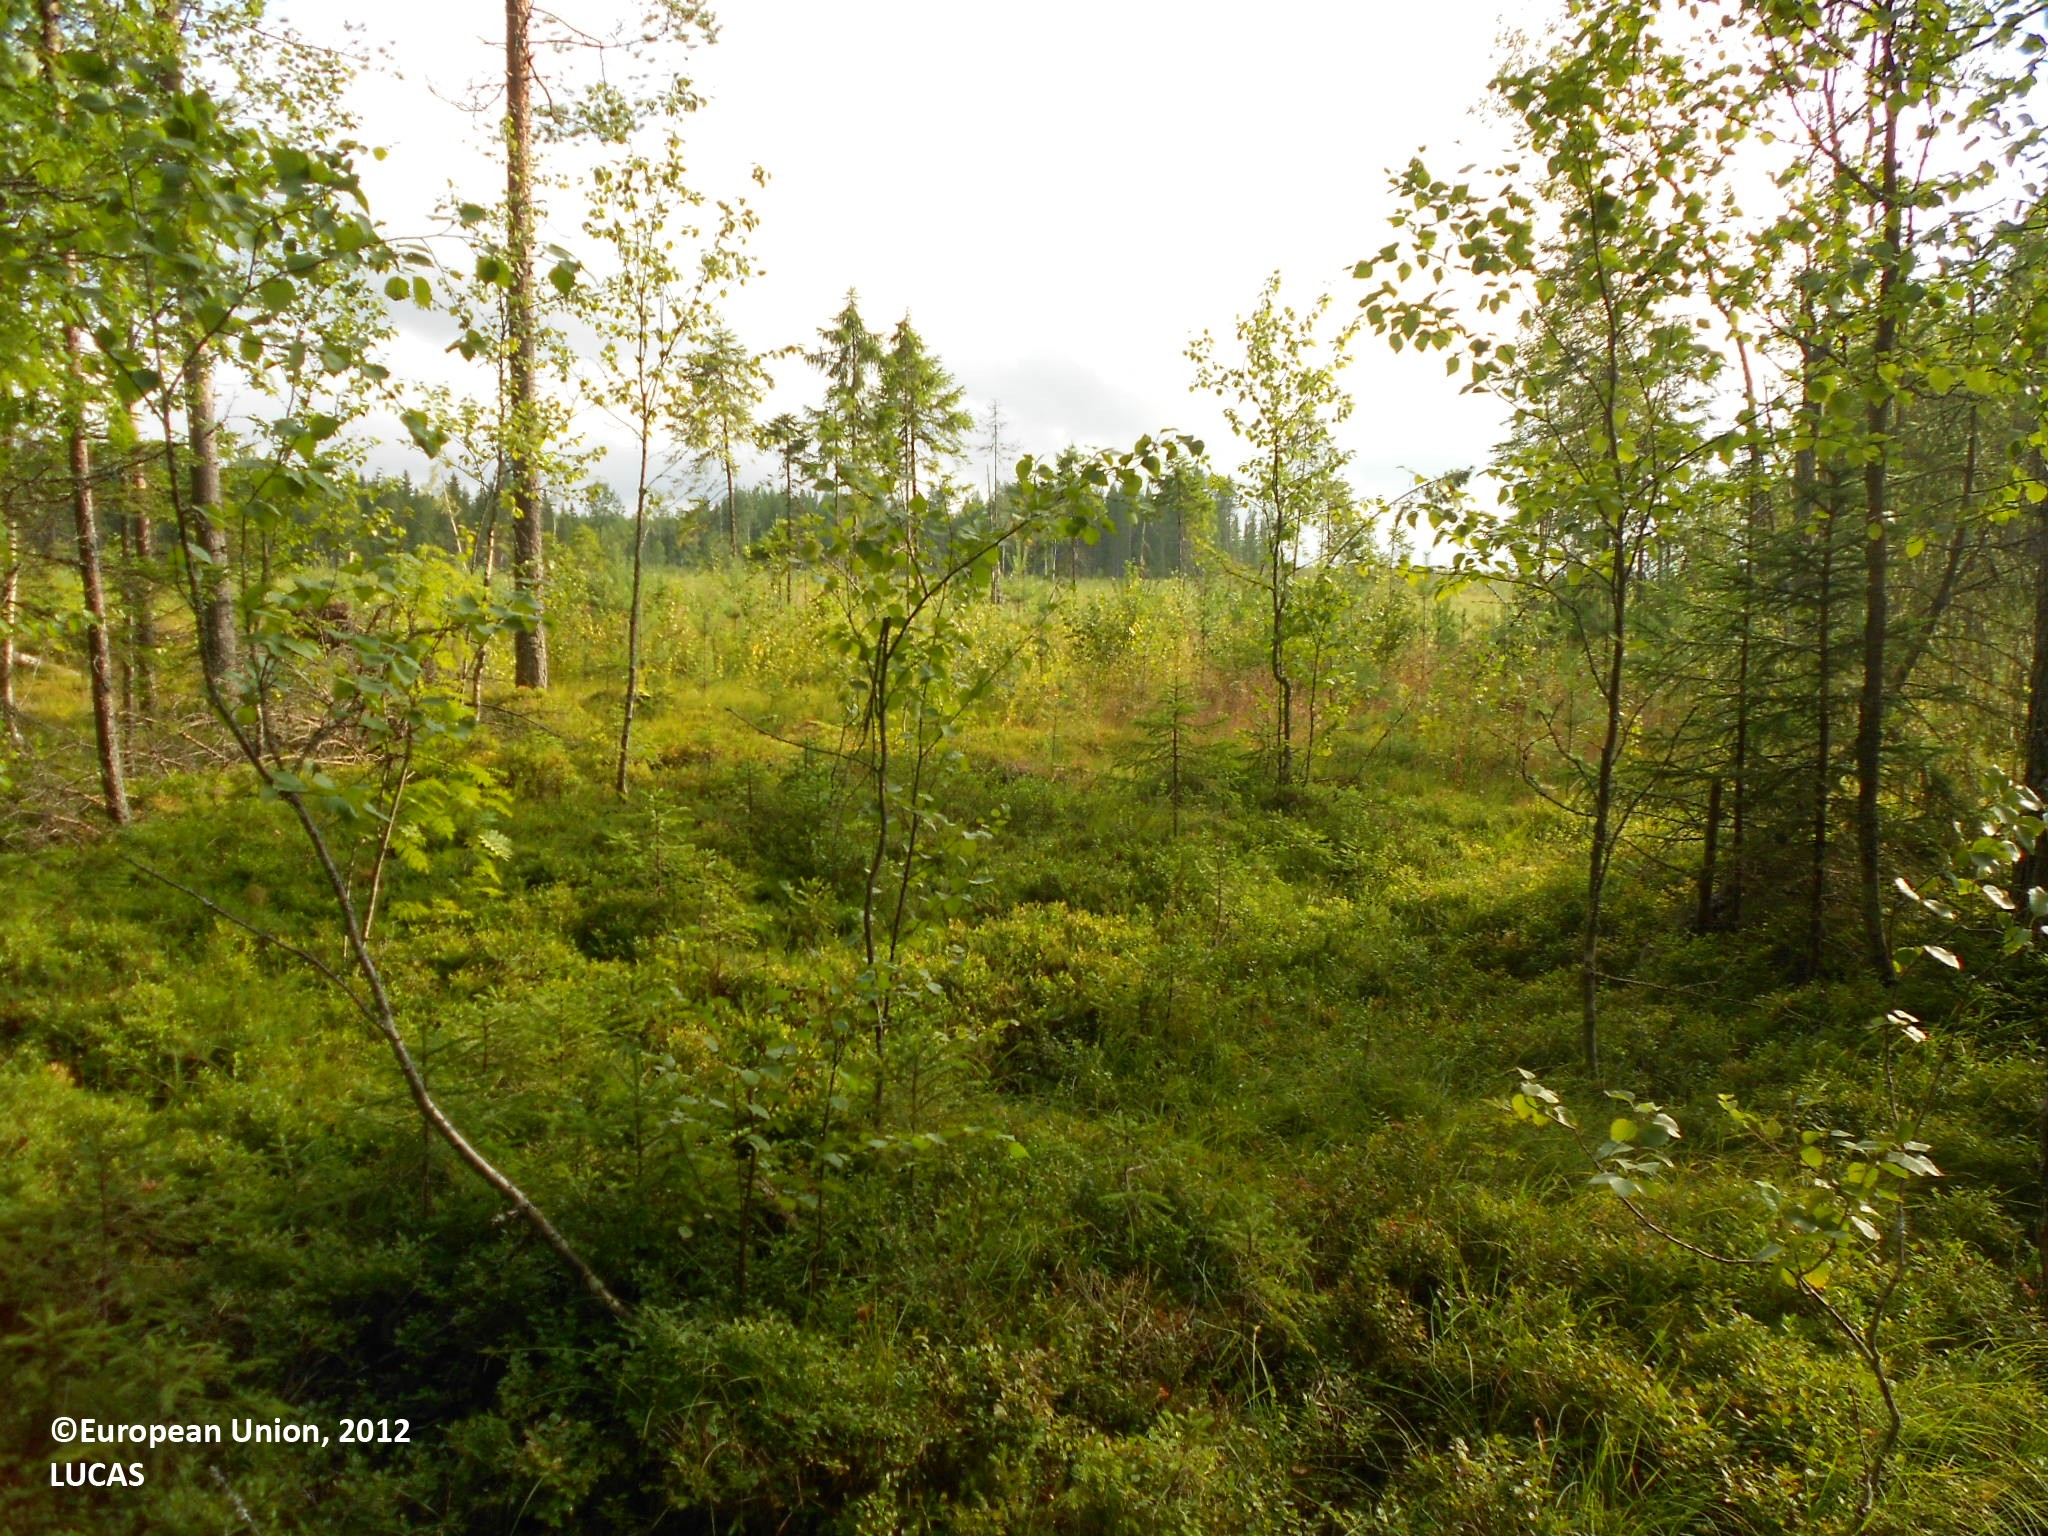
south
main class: Woodland
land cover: Spruce dominated coniferous woodland
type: boreal forest
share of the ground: > 75 %
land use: Forestry
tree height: > 5 m
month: August
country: FI
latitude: 63.4580
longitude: 28.8363
